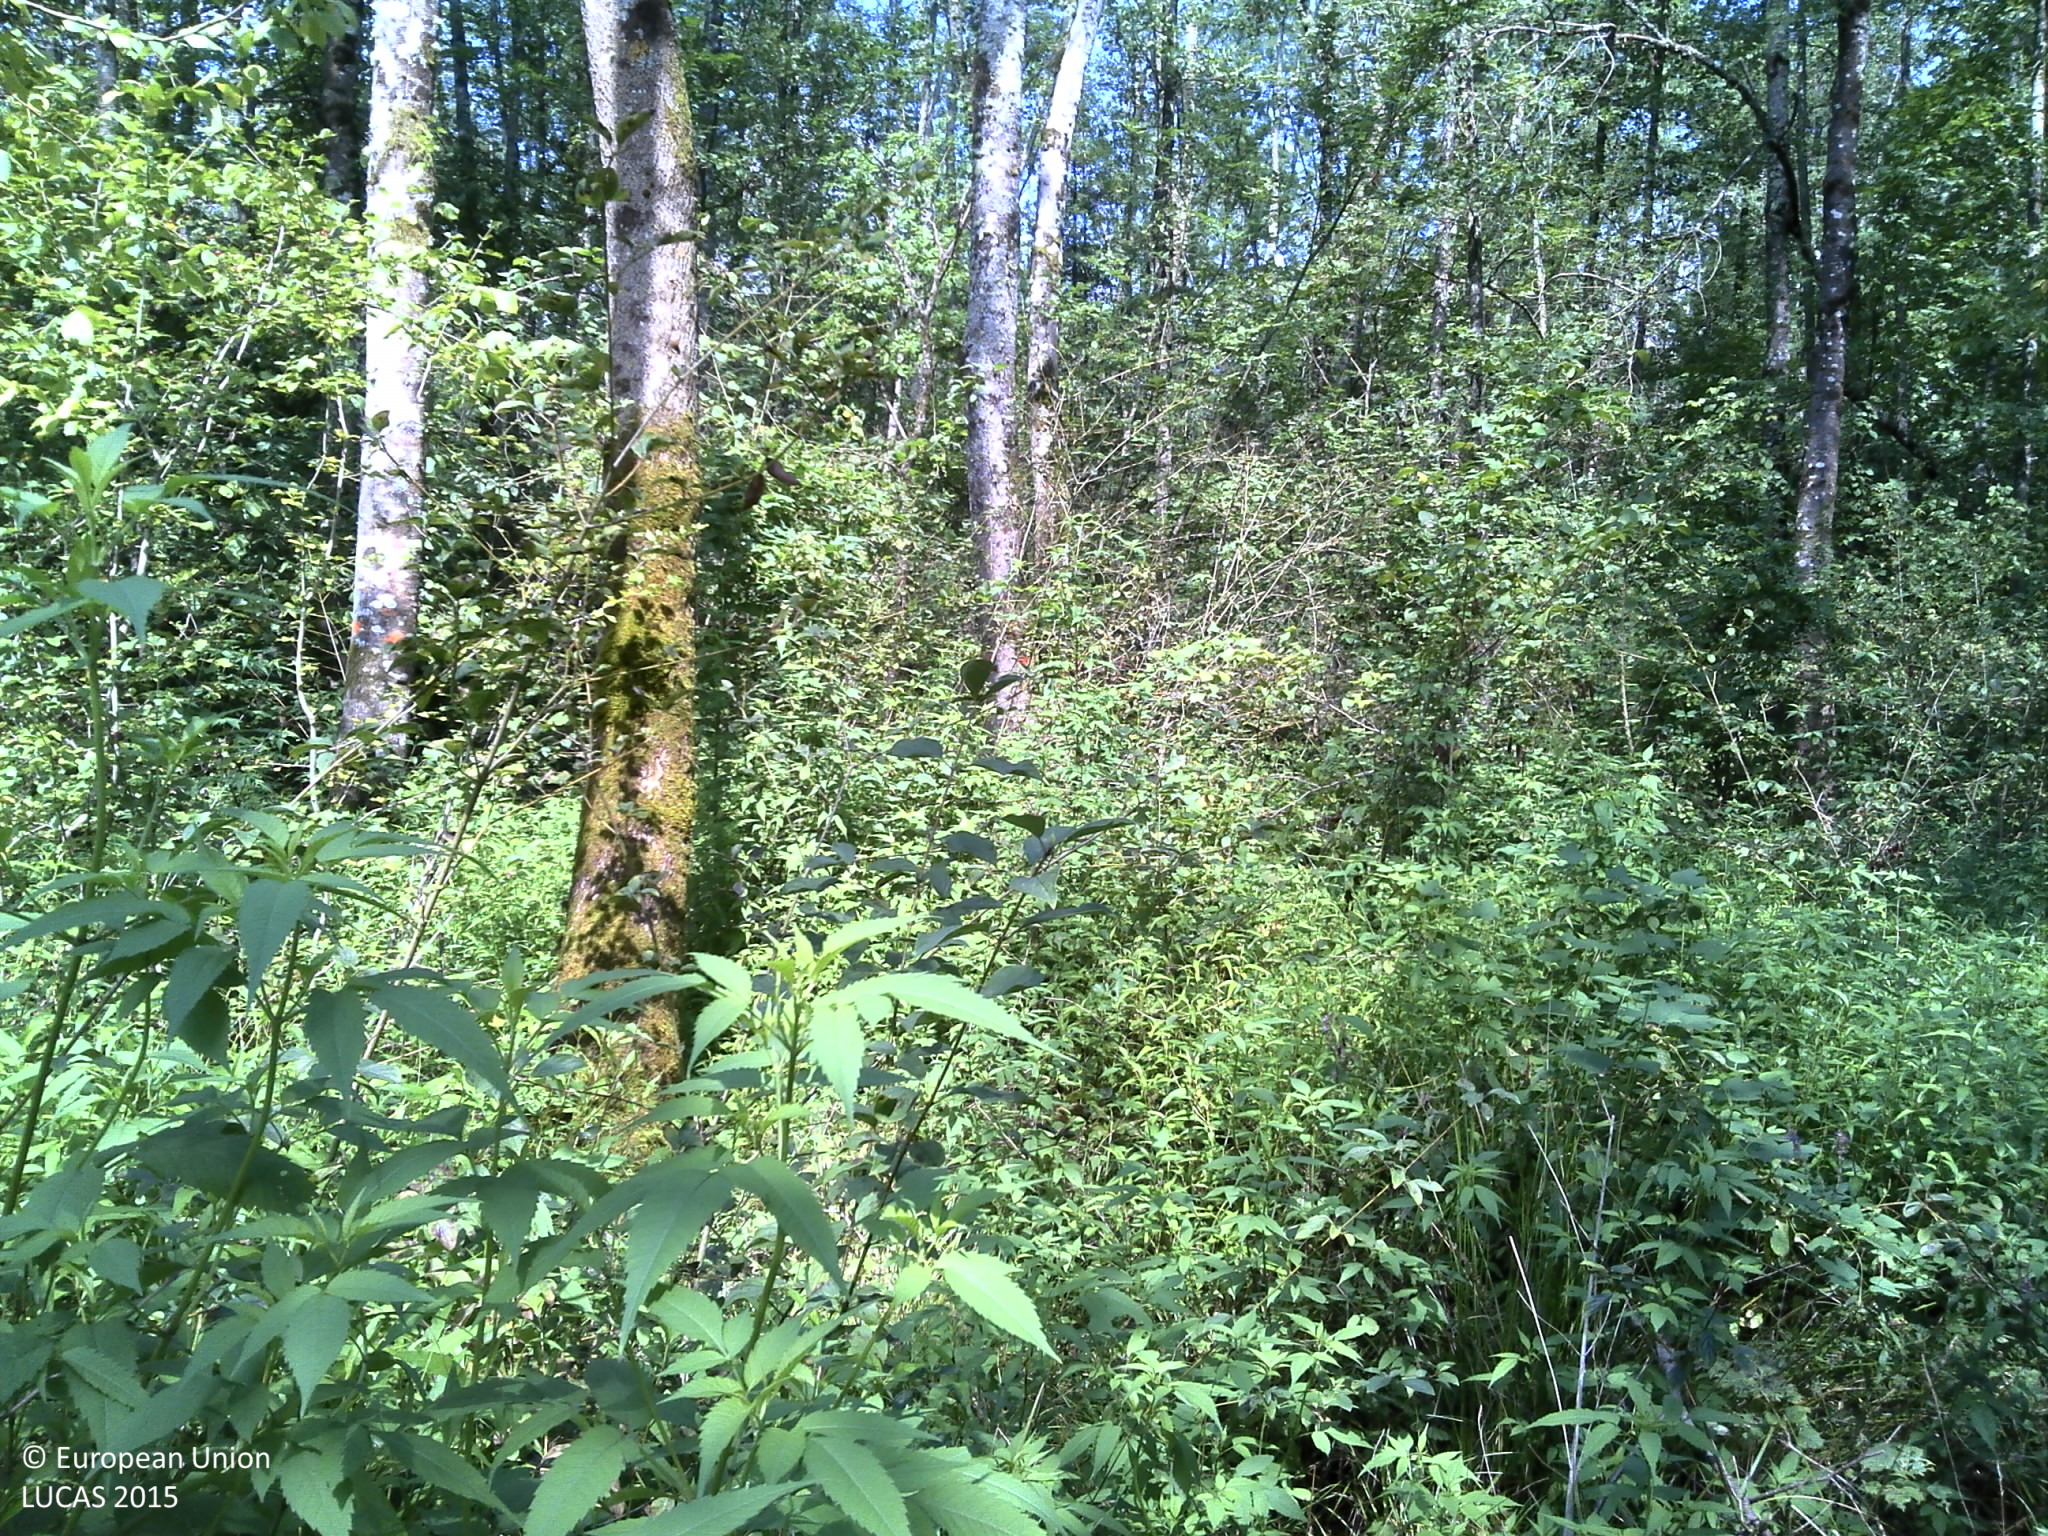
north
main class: Woodland
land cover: Broadleaved woodland
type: mesophytic deciduous forest
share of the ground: > 75 %
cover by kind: broadleaved forest trees 100 %
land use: Forestry
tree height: > 5 m
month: August
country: HR
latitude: 45.5838
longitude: 15.7258
